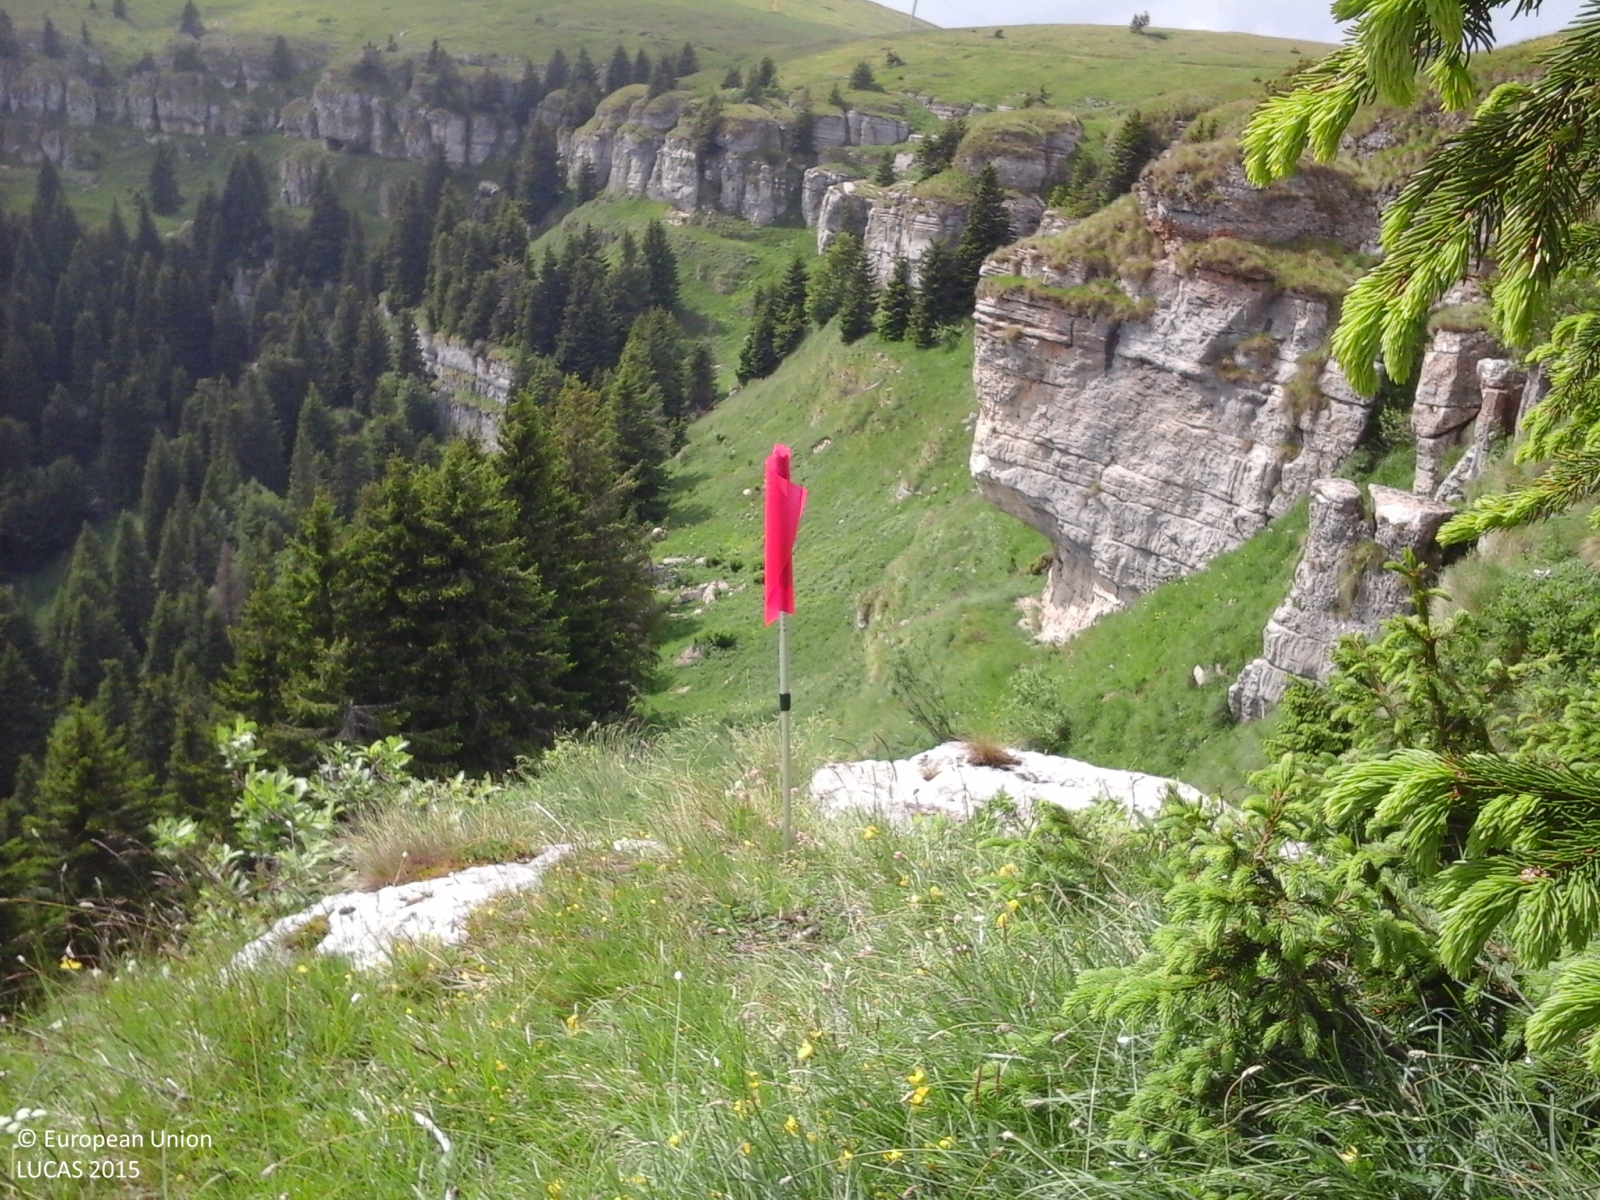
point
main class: Grassland
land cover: Grassland with sparse tree/shrub cover
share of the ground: > 75 %
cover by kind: herbaceous plants 95 %, coniferous forest trees 5 %
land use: Semi-natural and natural areas not in use
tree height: < 5 m
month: June
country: IT
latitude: 45.8755
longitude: 11.2478
